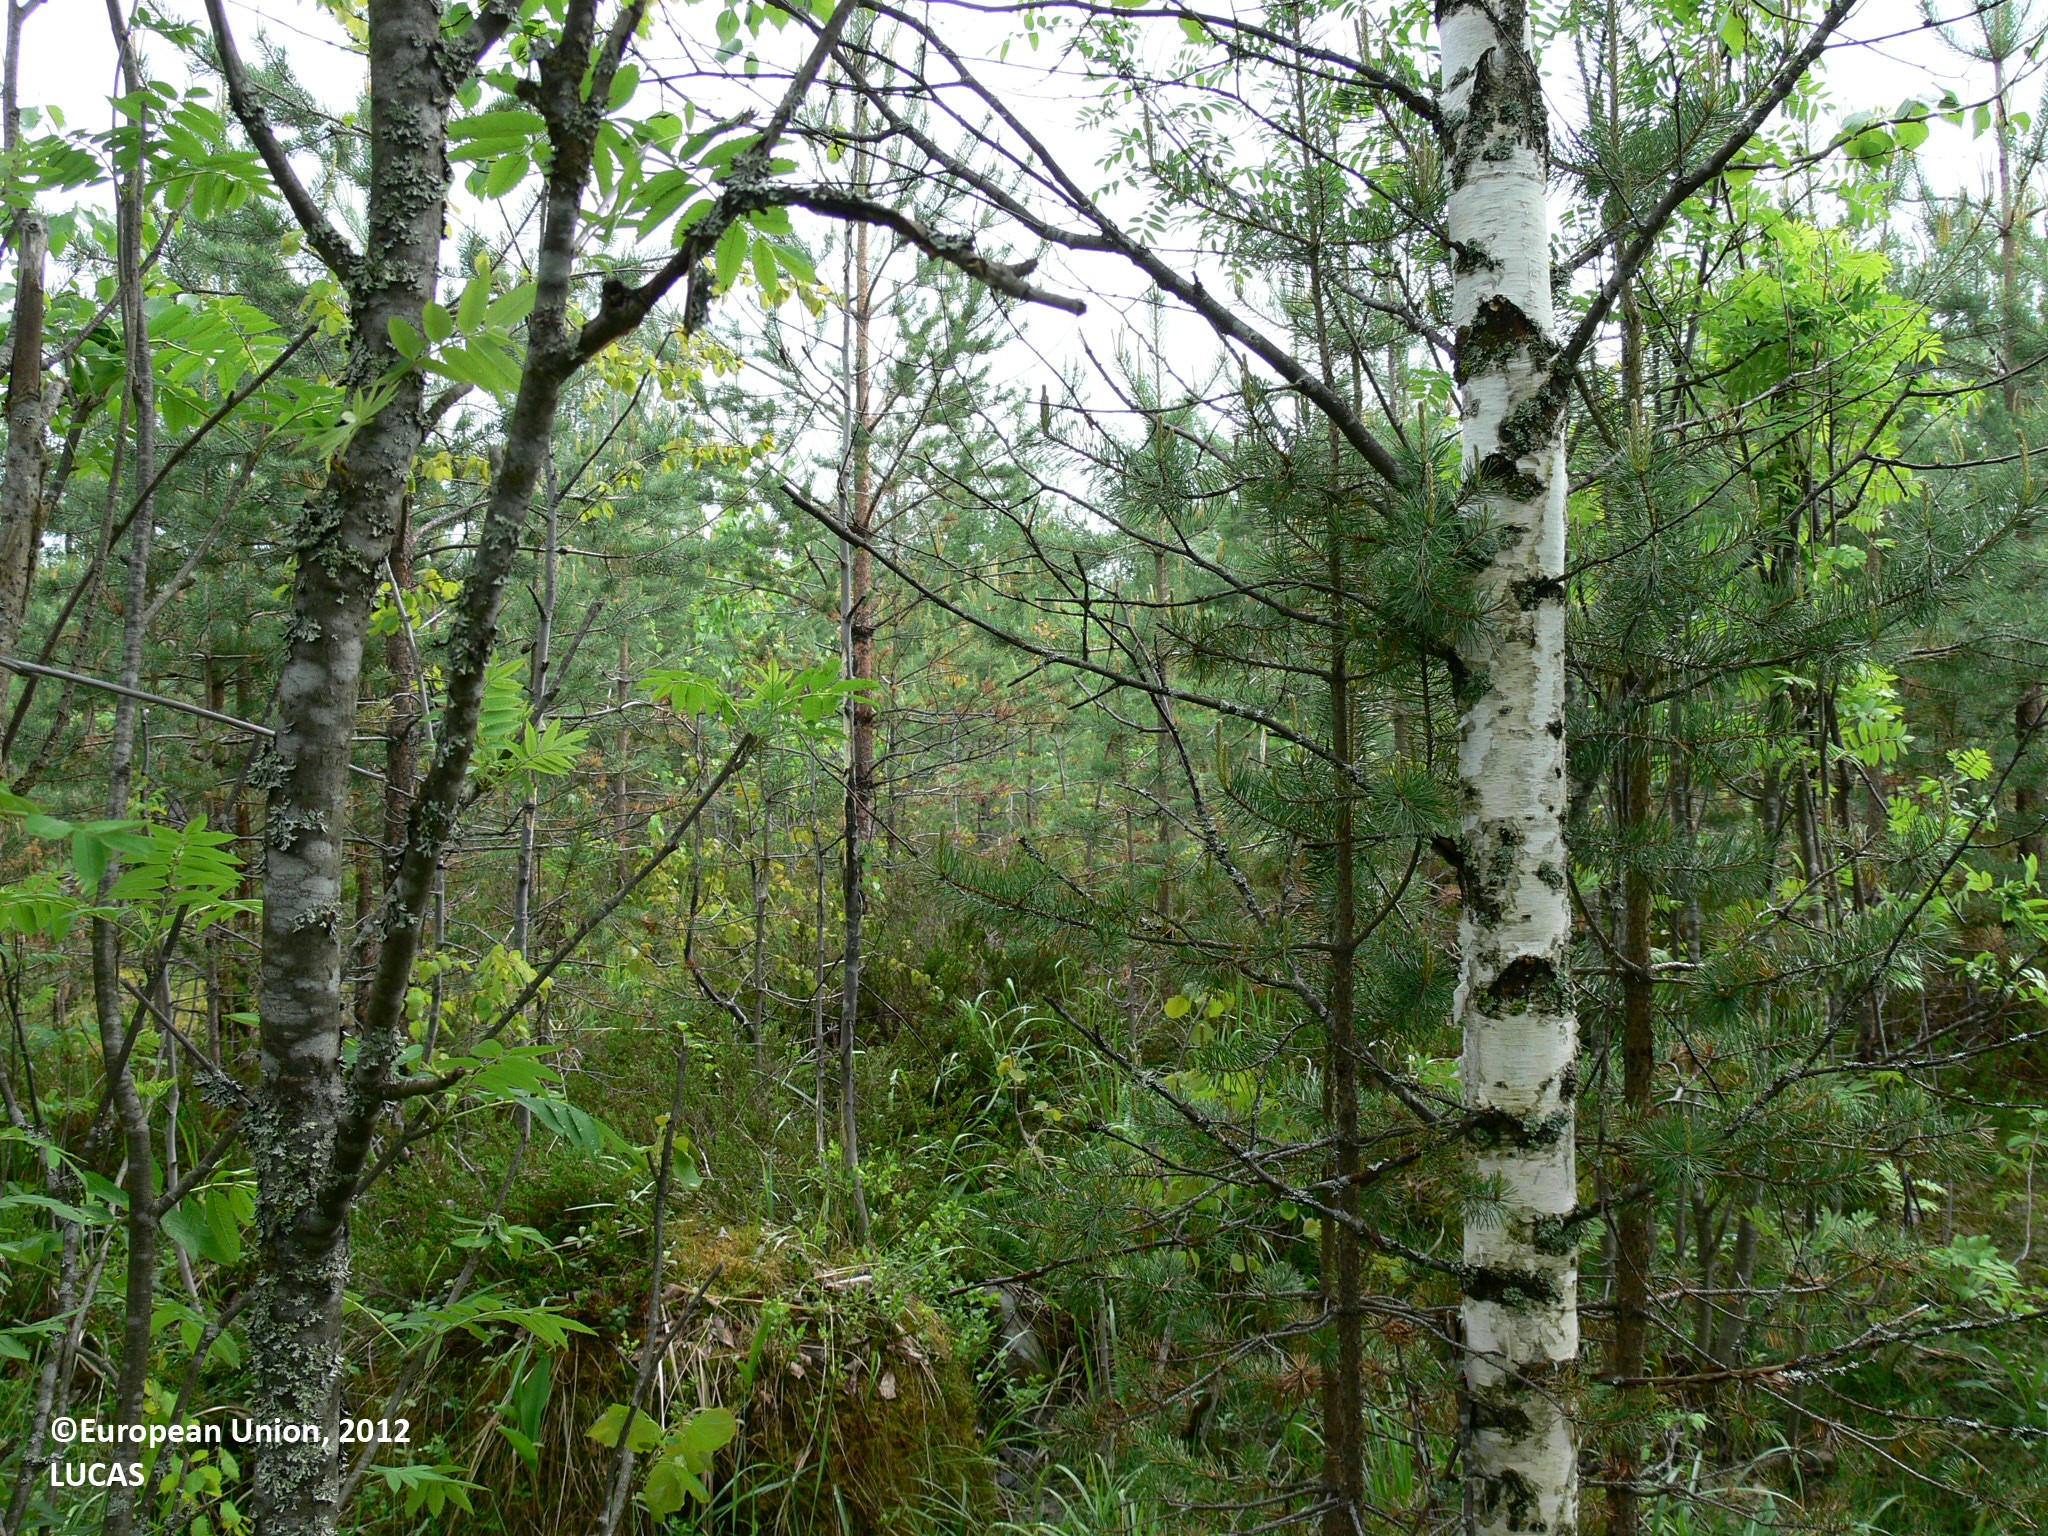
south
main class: Woodland
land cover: Other mixed woodland
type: boreal forest
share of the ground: 50 - 75 %
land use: Forestry
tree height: > 5 m
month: June
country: FI
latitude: 62.4256
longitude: 30.2768
